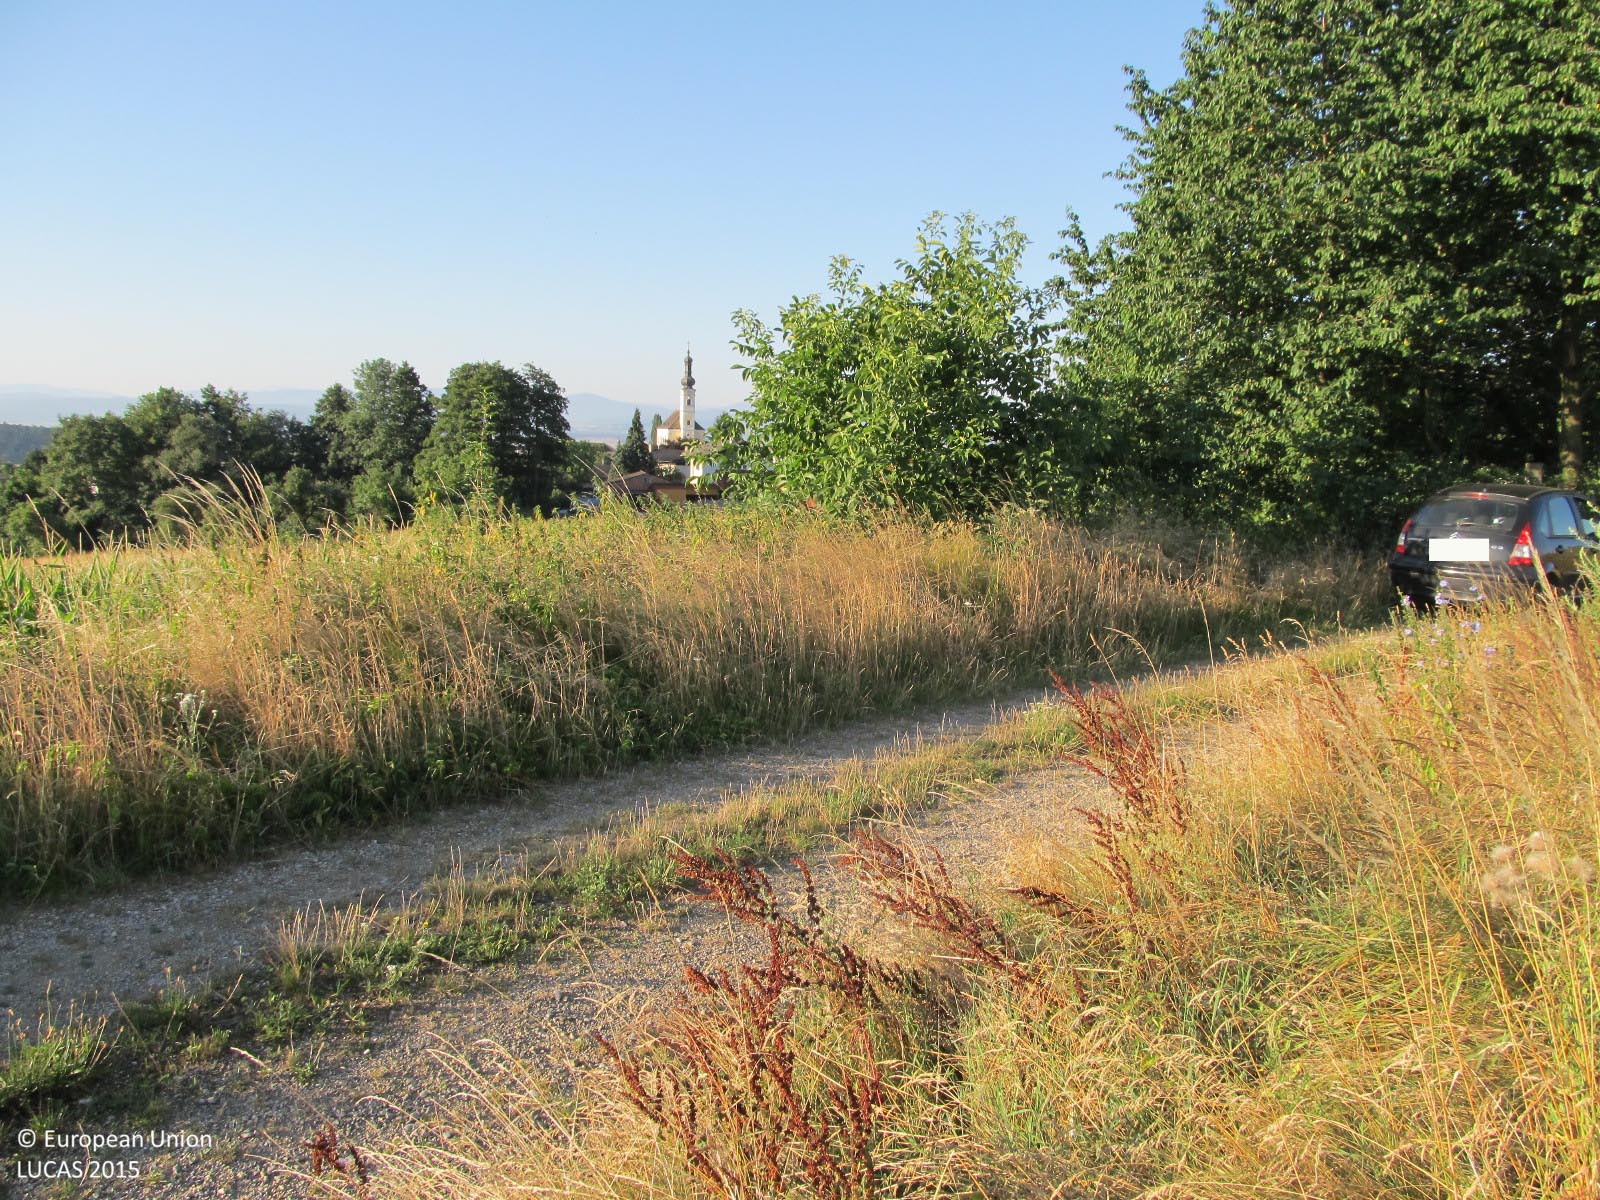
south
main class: Grassland
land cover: Grassland without tree/shrub cover
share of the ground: > 75 %
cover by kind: herbaceous plants 100 %
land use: Agriculture (excluding fallow land and kitchen gardens)
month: July
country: AT
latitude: 48.2633
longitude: 15.5662
